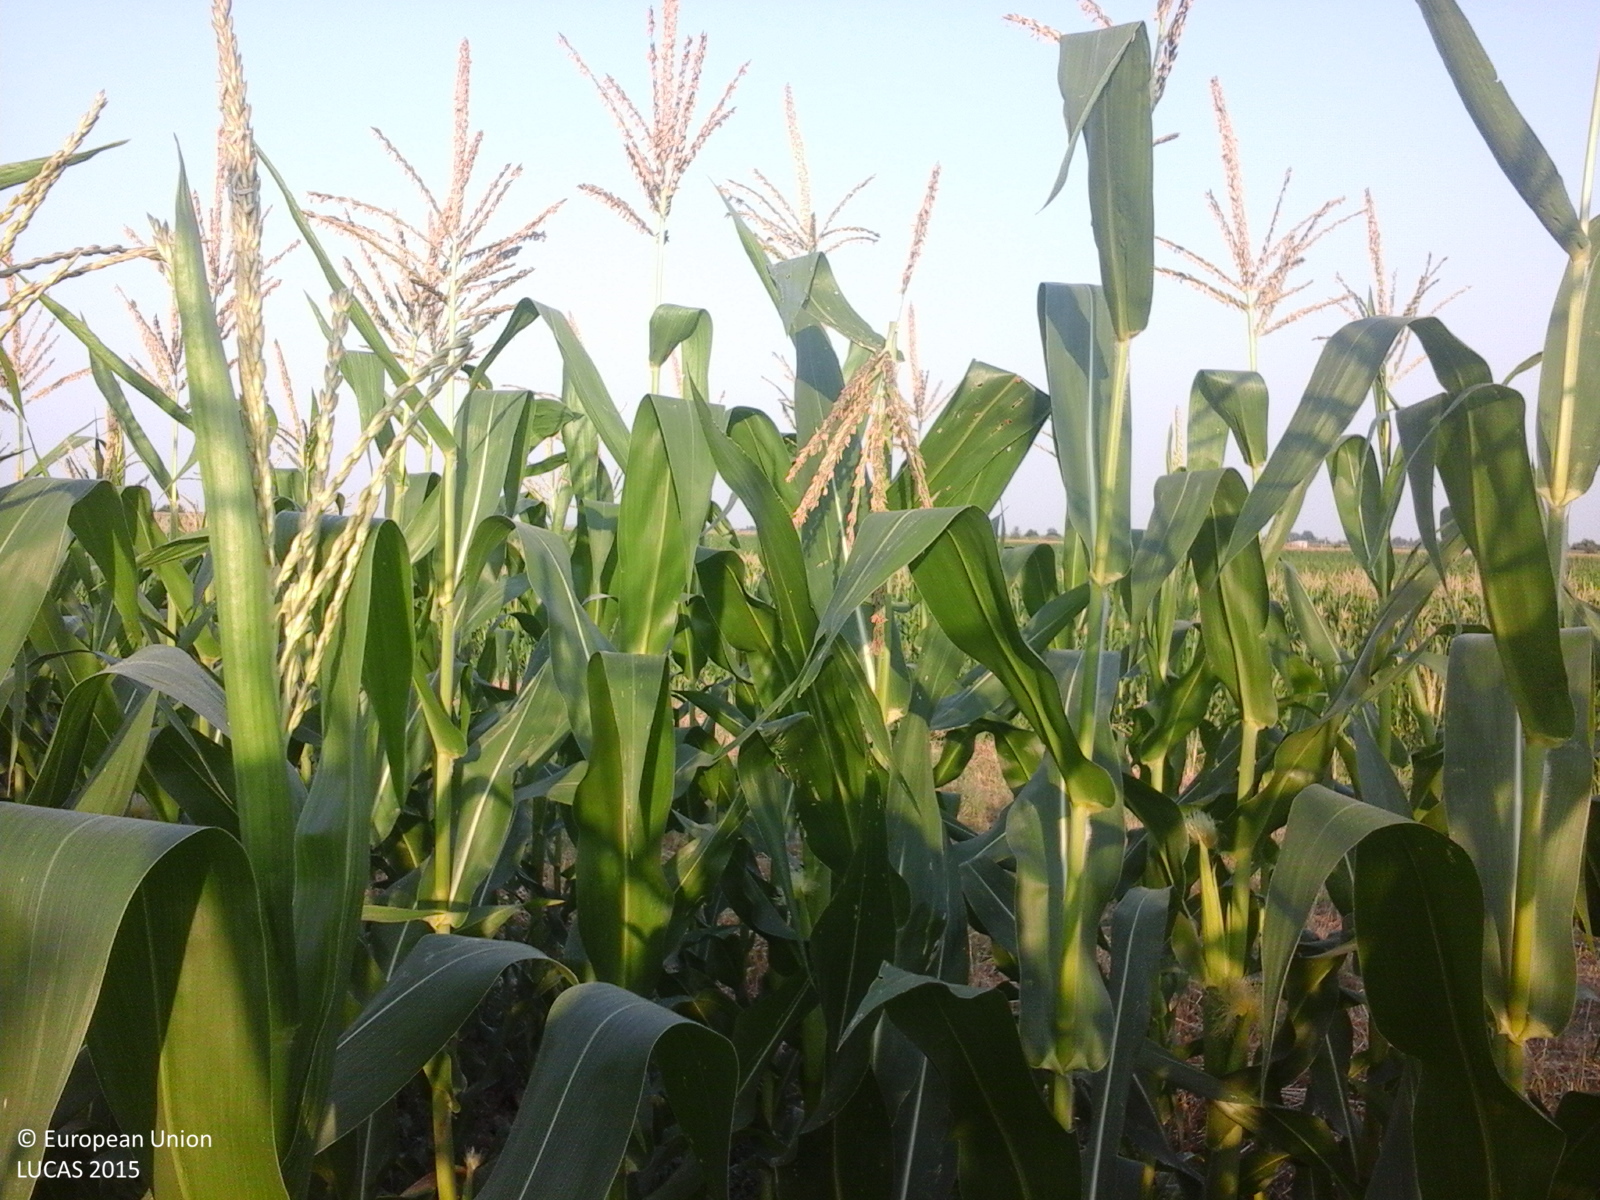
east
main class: Cropland
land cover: Maize
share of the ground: > 75 %
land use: Agriculture (excluding fallow land and kitchen gardens)
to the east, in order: Maize; Oats; Maize
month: July
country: RO
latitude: 44.5785
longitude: 25.5721
